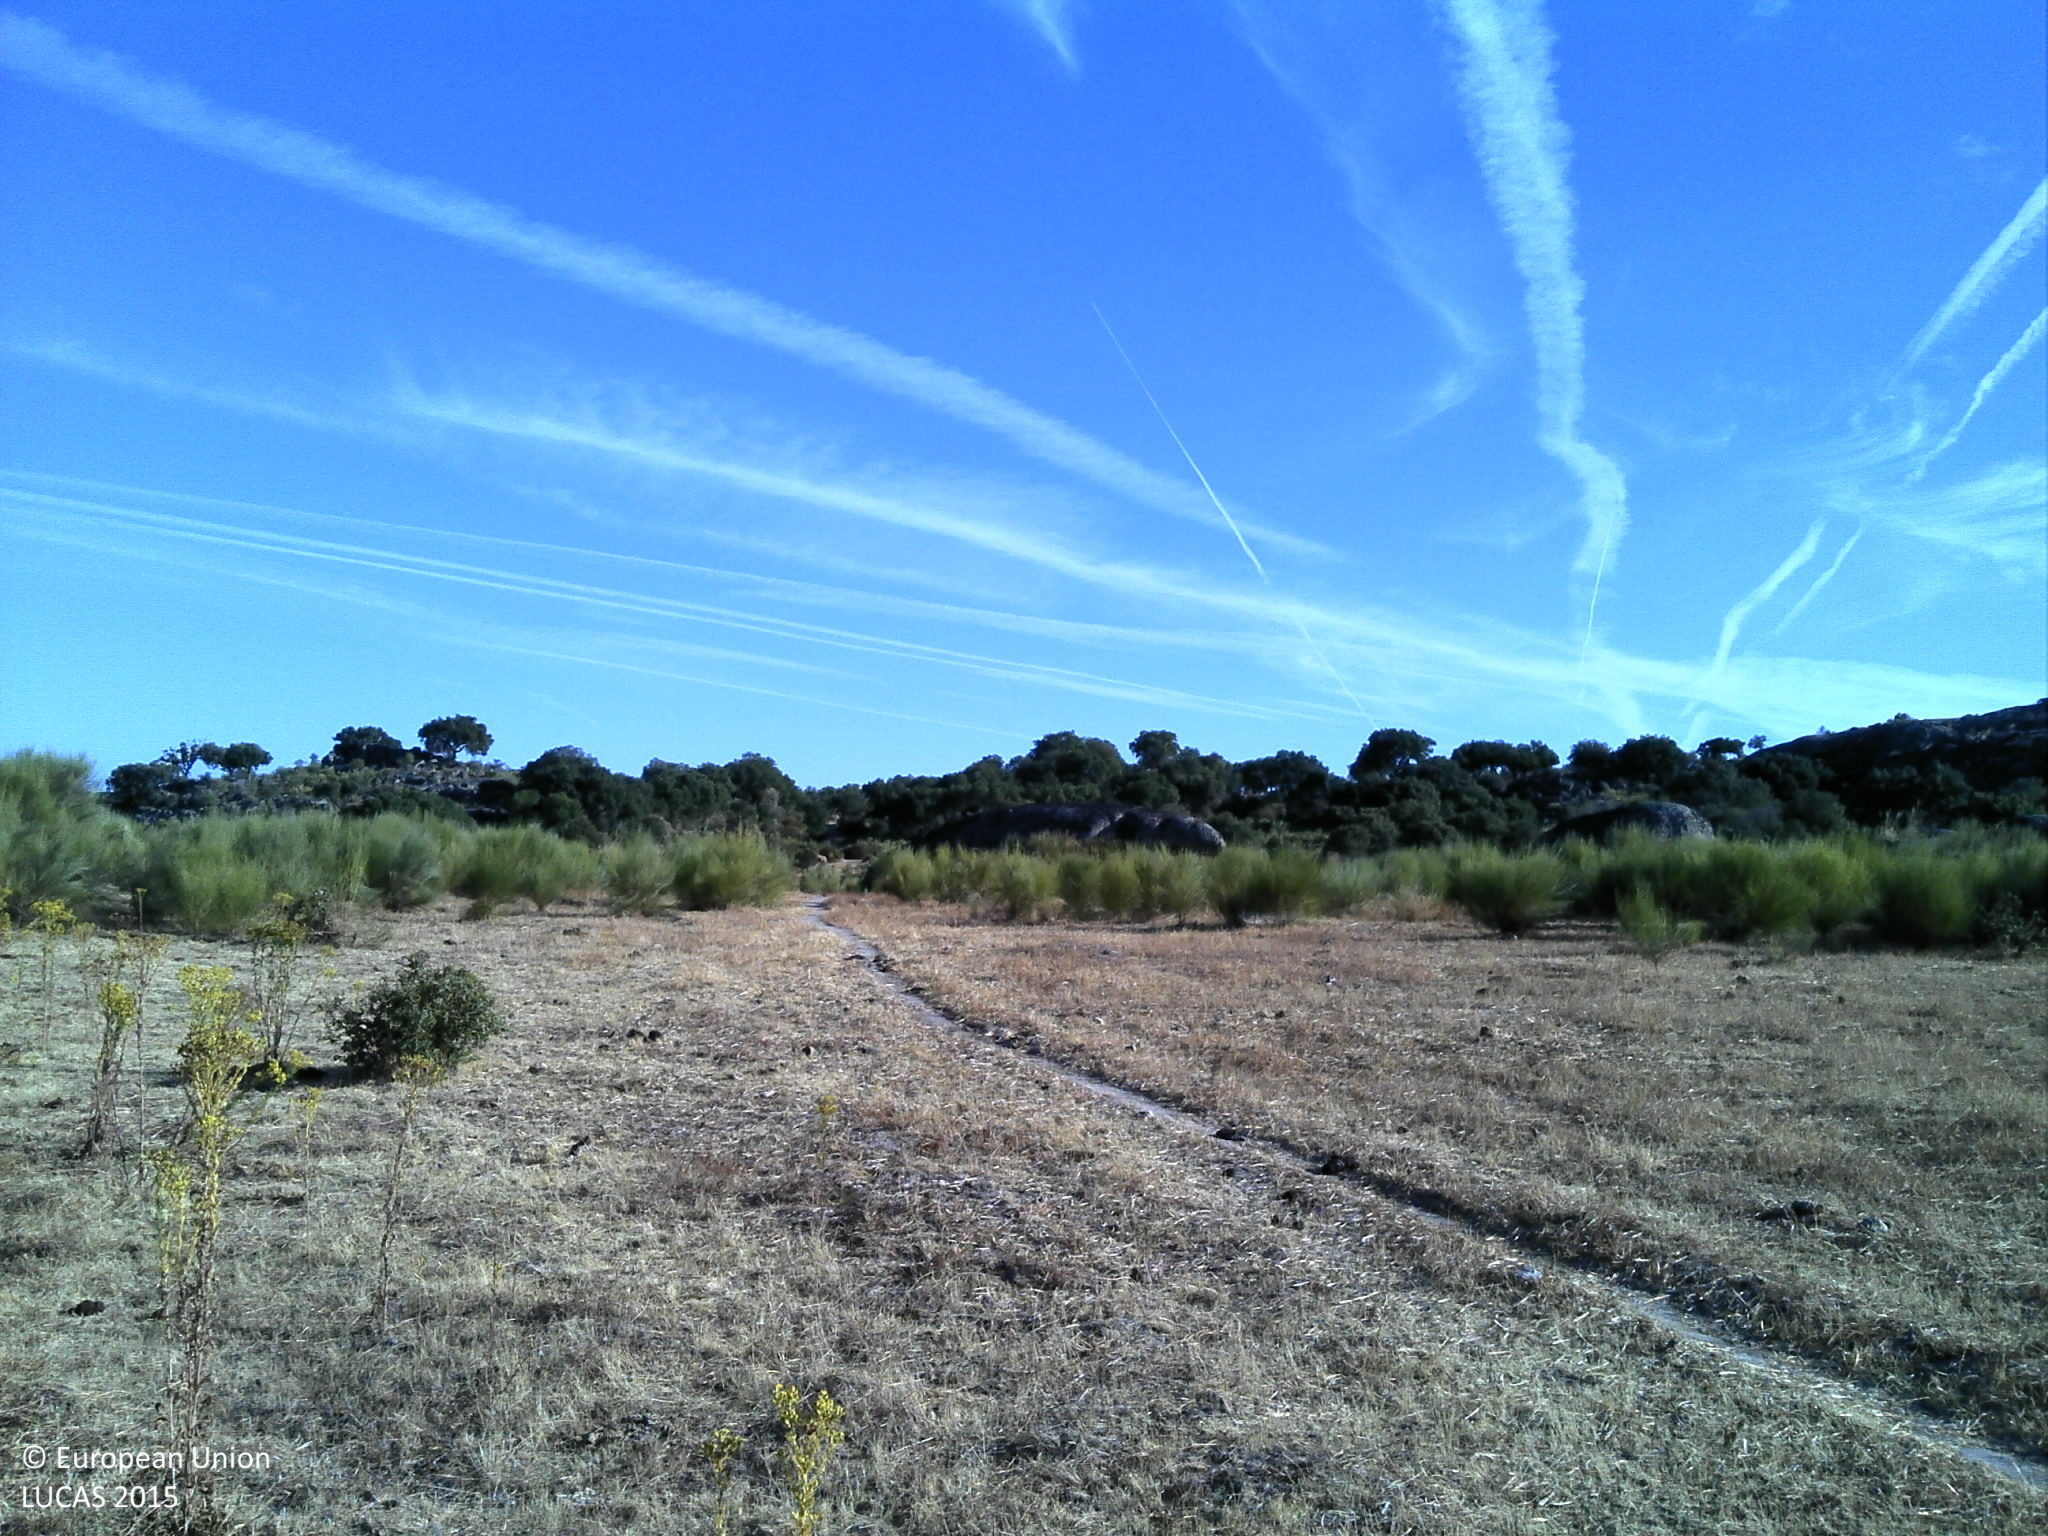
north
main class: Grassland
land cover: Grassland with sparse tree/shrub cover
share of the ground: 50 - 75 %
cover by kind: herbaceous plants 55 %, unconsolidated bare surface 35 %, broadleaved forest trees 5 %, shrubs 5 %
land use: Agriculture (excluding fallow land and kitchen gardens)
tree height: < 5 m
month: August
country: PT
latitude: 39.4702
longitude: -7.4223
